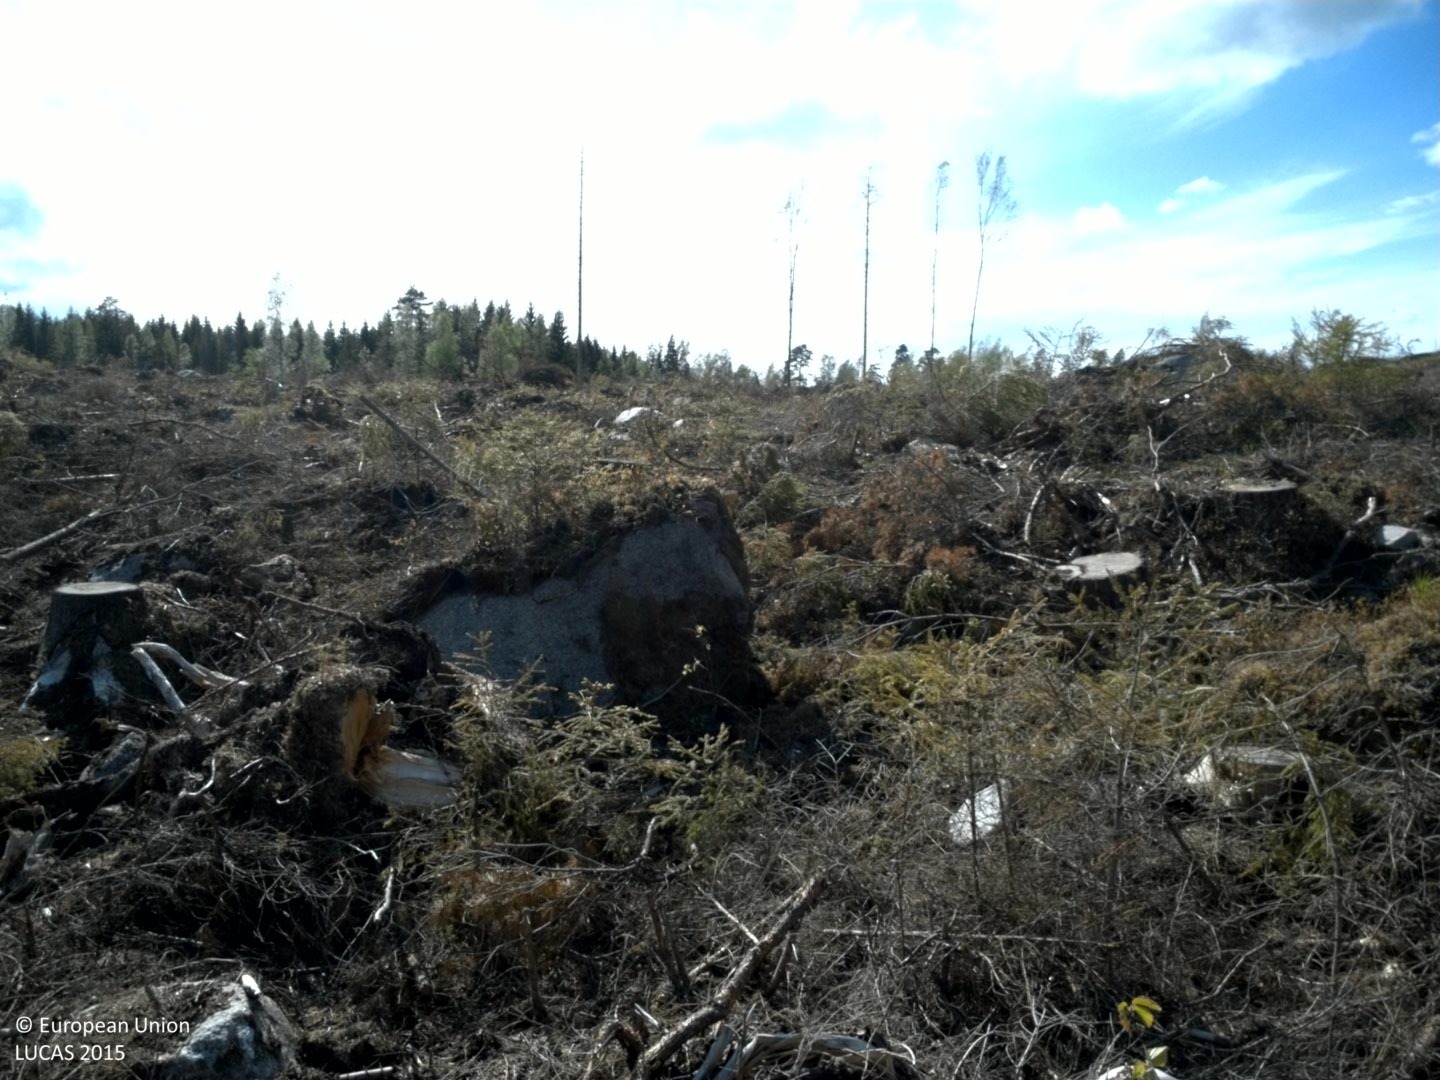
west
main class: Woodland
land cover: Spruce dominated coniferous woodland
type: boreal forest
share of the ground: 10 - 25 %
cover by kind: shrubs 75 %, lichens and mosses 15 %, coniferous forest trees 10 %
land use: Forestry
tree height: < 5 m
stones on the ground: 10 - 25 %
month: May
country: SE
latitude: 59.1023
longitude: 14.4092
